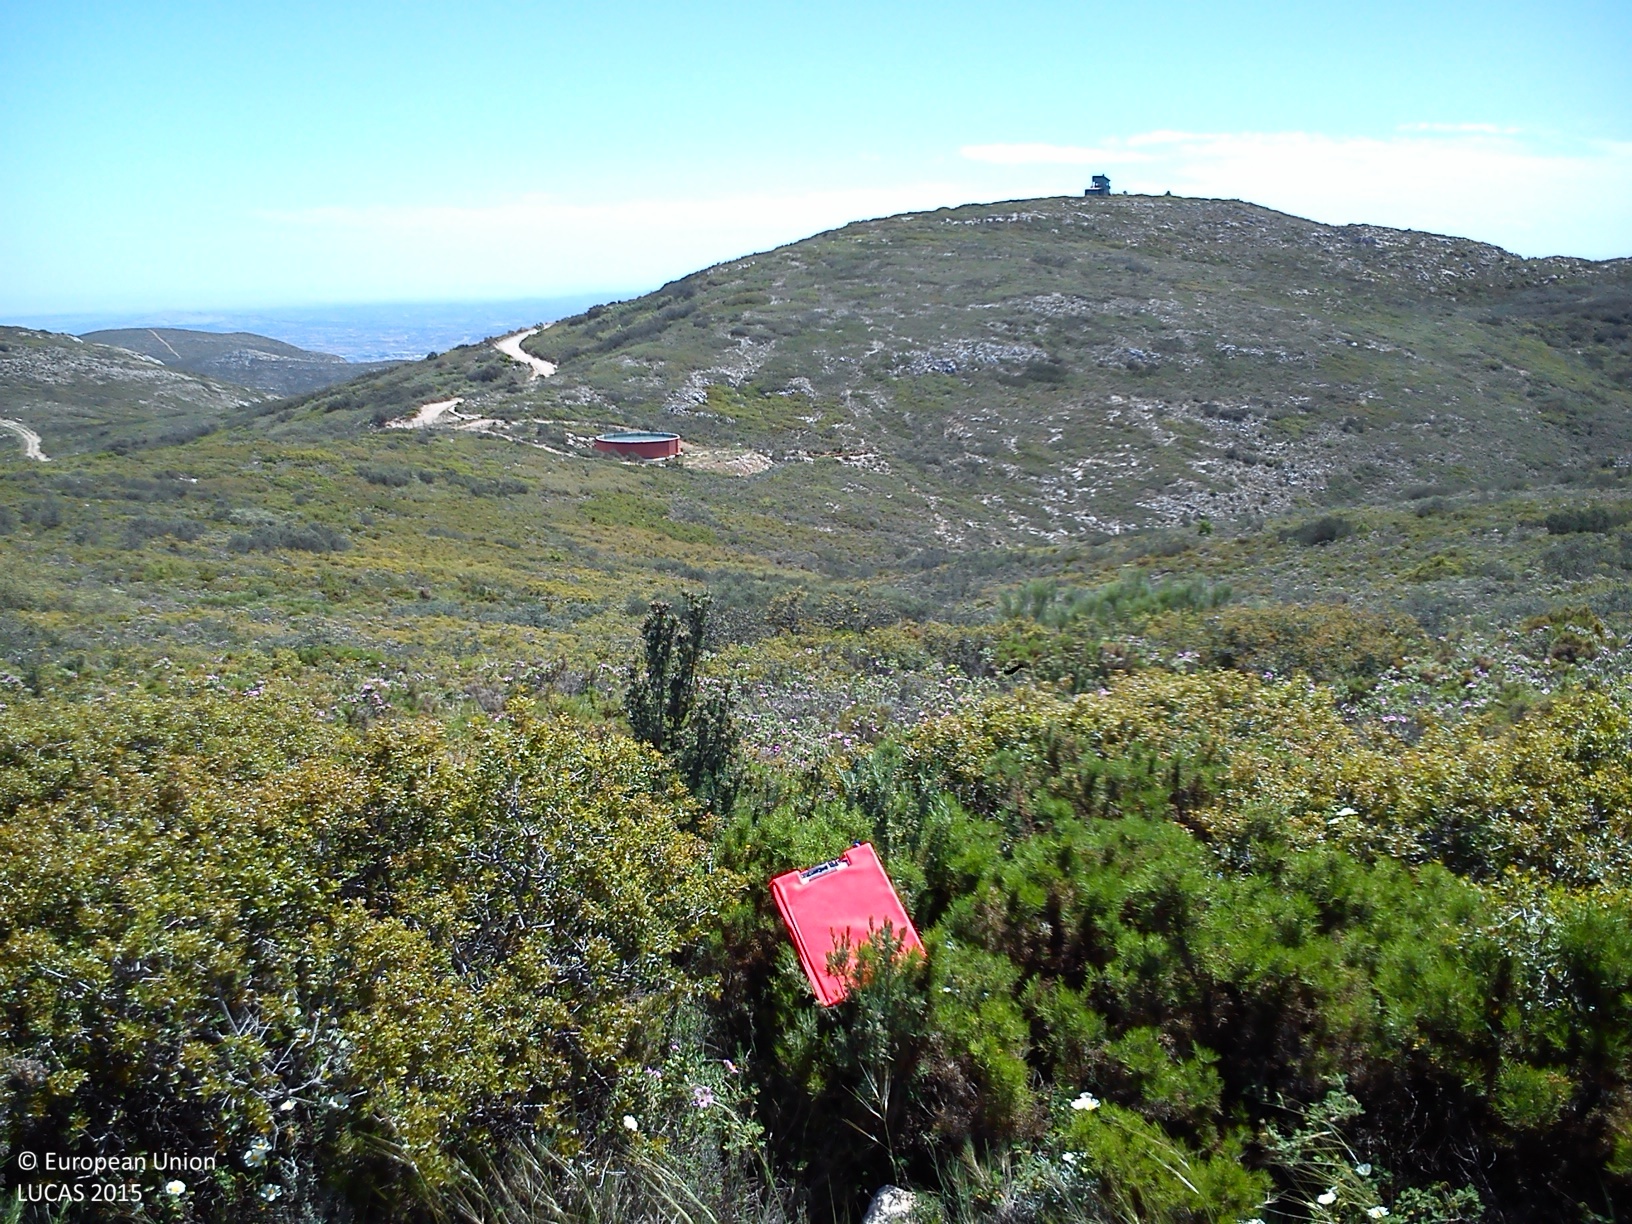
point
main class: Shrubland
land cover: Shrubland without tree cover
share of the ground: > 75 %
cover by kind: shrubs 85 %, consolidated bare surface 10 %, herbaceous plants 5 %
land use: Semi-natural and natural areas not in use
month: May
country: ES
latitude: 39.5380
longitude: -0.8327
